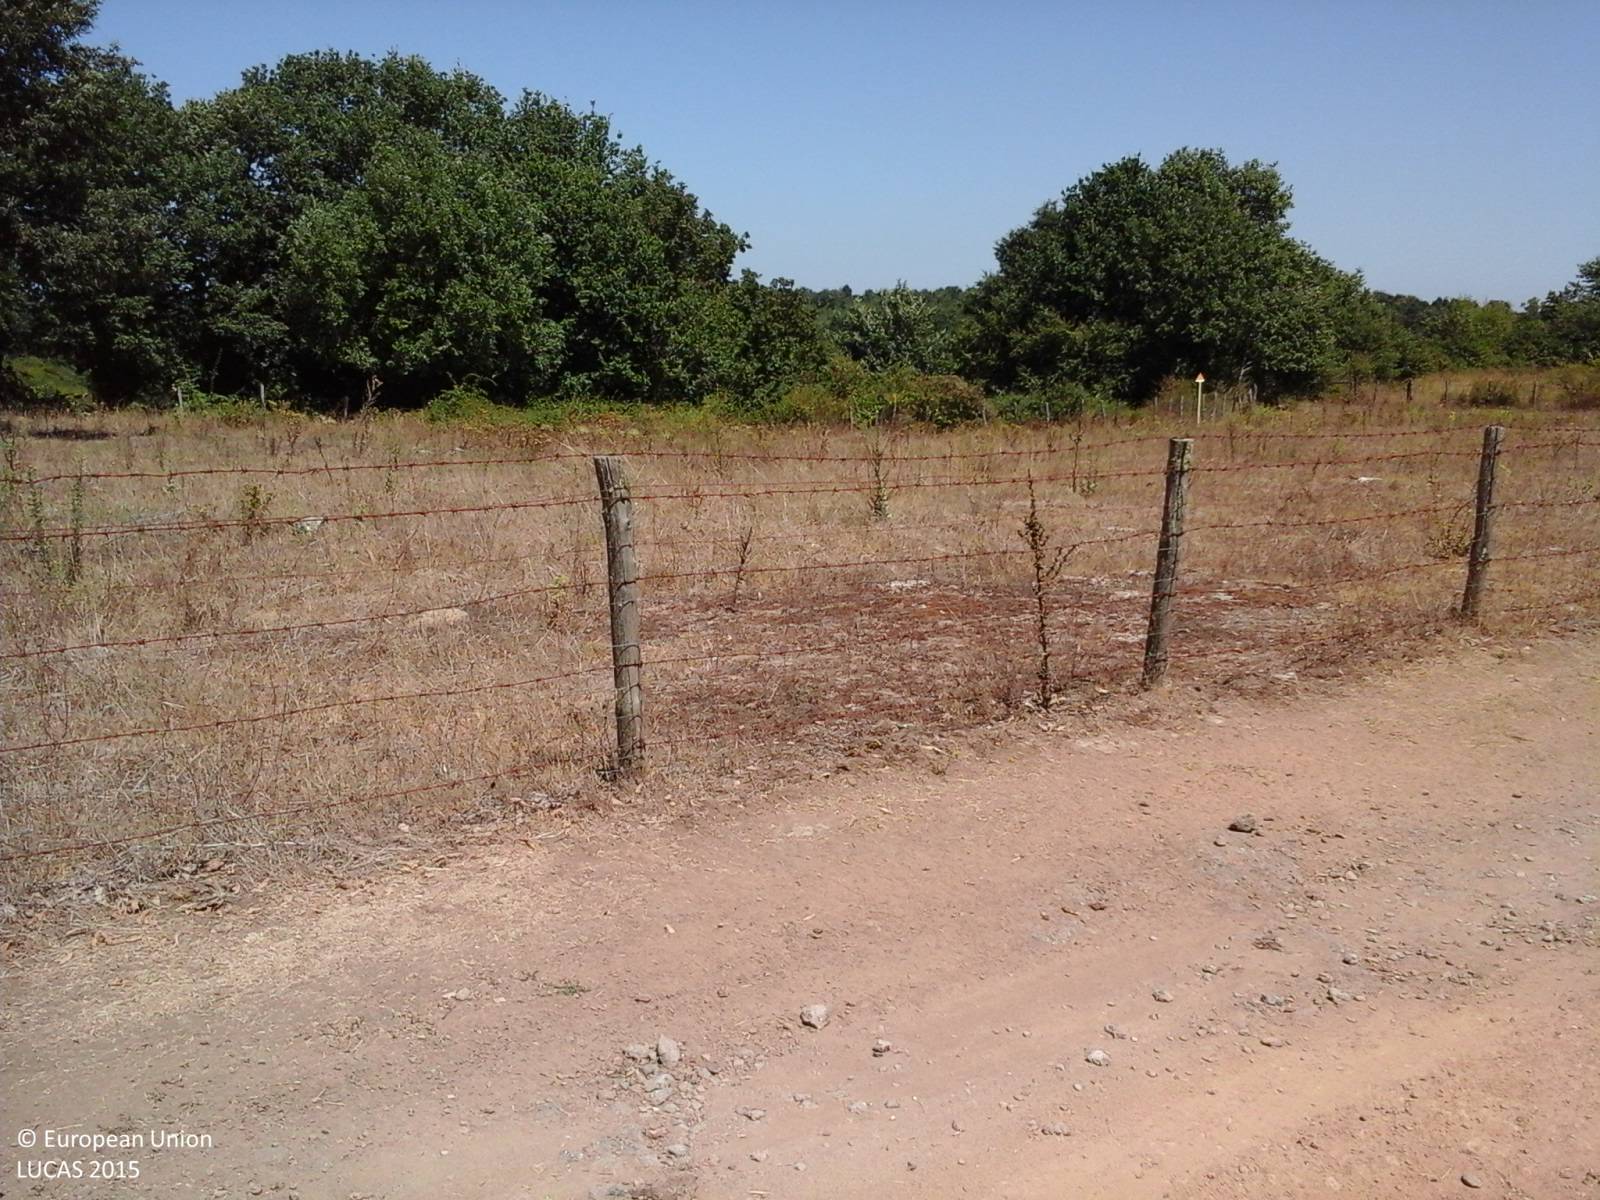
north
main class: Grassland
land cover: Grassland with sparse tree/shrub cover
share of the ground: > 75 %
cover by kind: herbaceous plants 60 %, unconsolidated bare surface 35 %, broadleaved forest trees 5 %
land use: Agriculture (excluding fallow land and kitchen gardens)
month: July
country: IT
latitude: 42.2116
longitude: 12.3296
